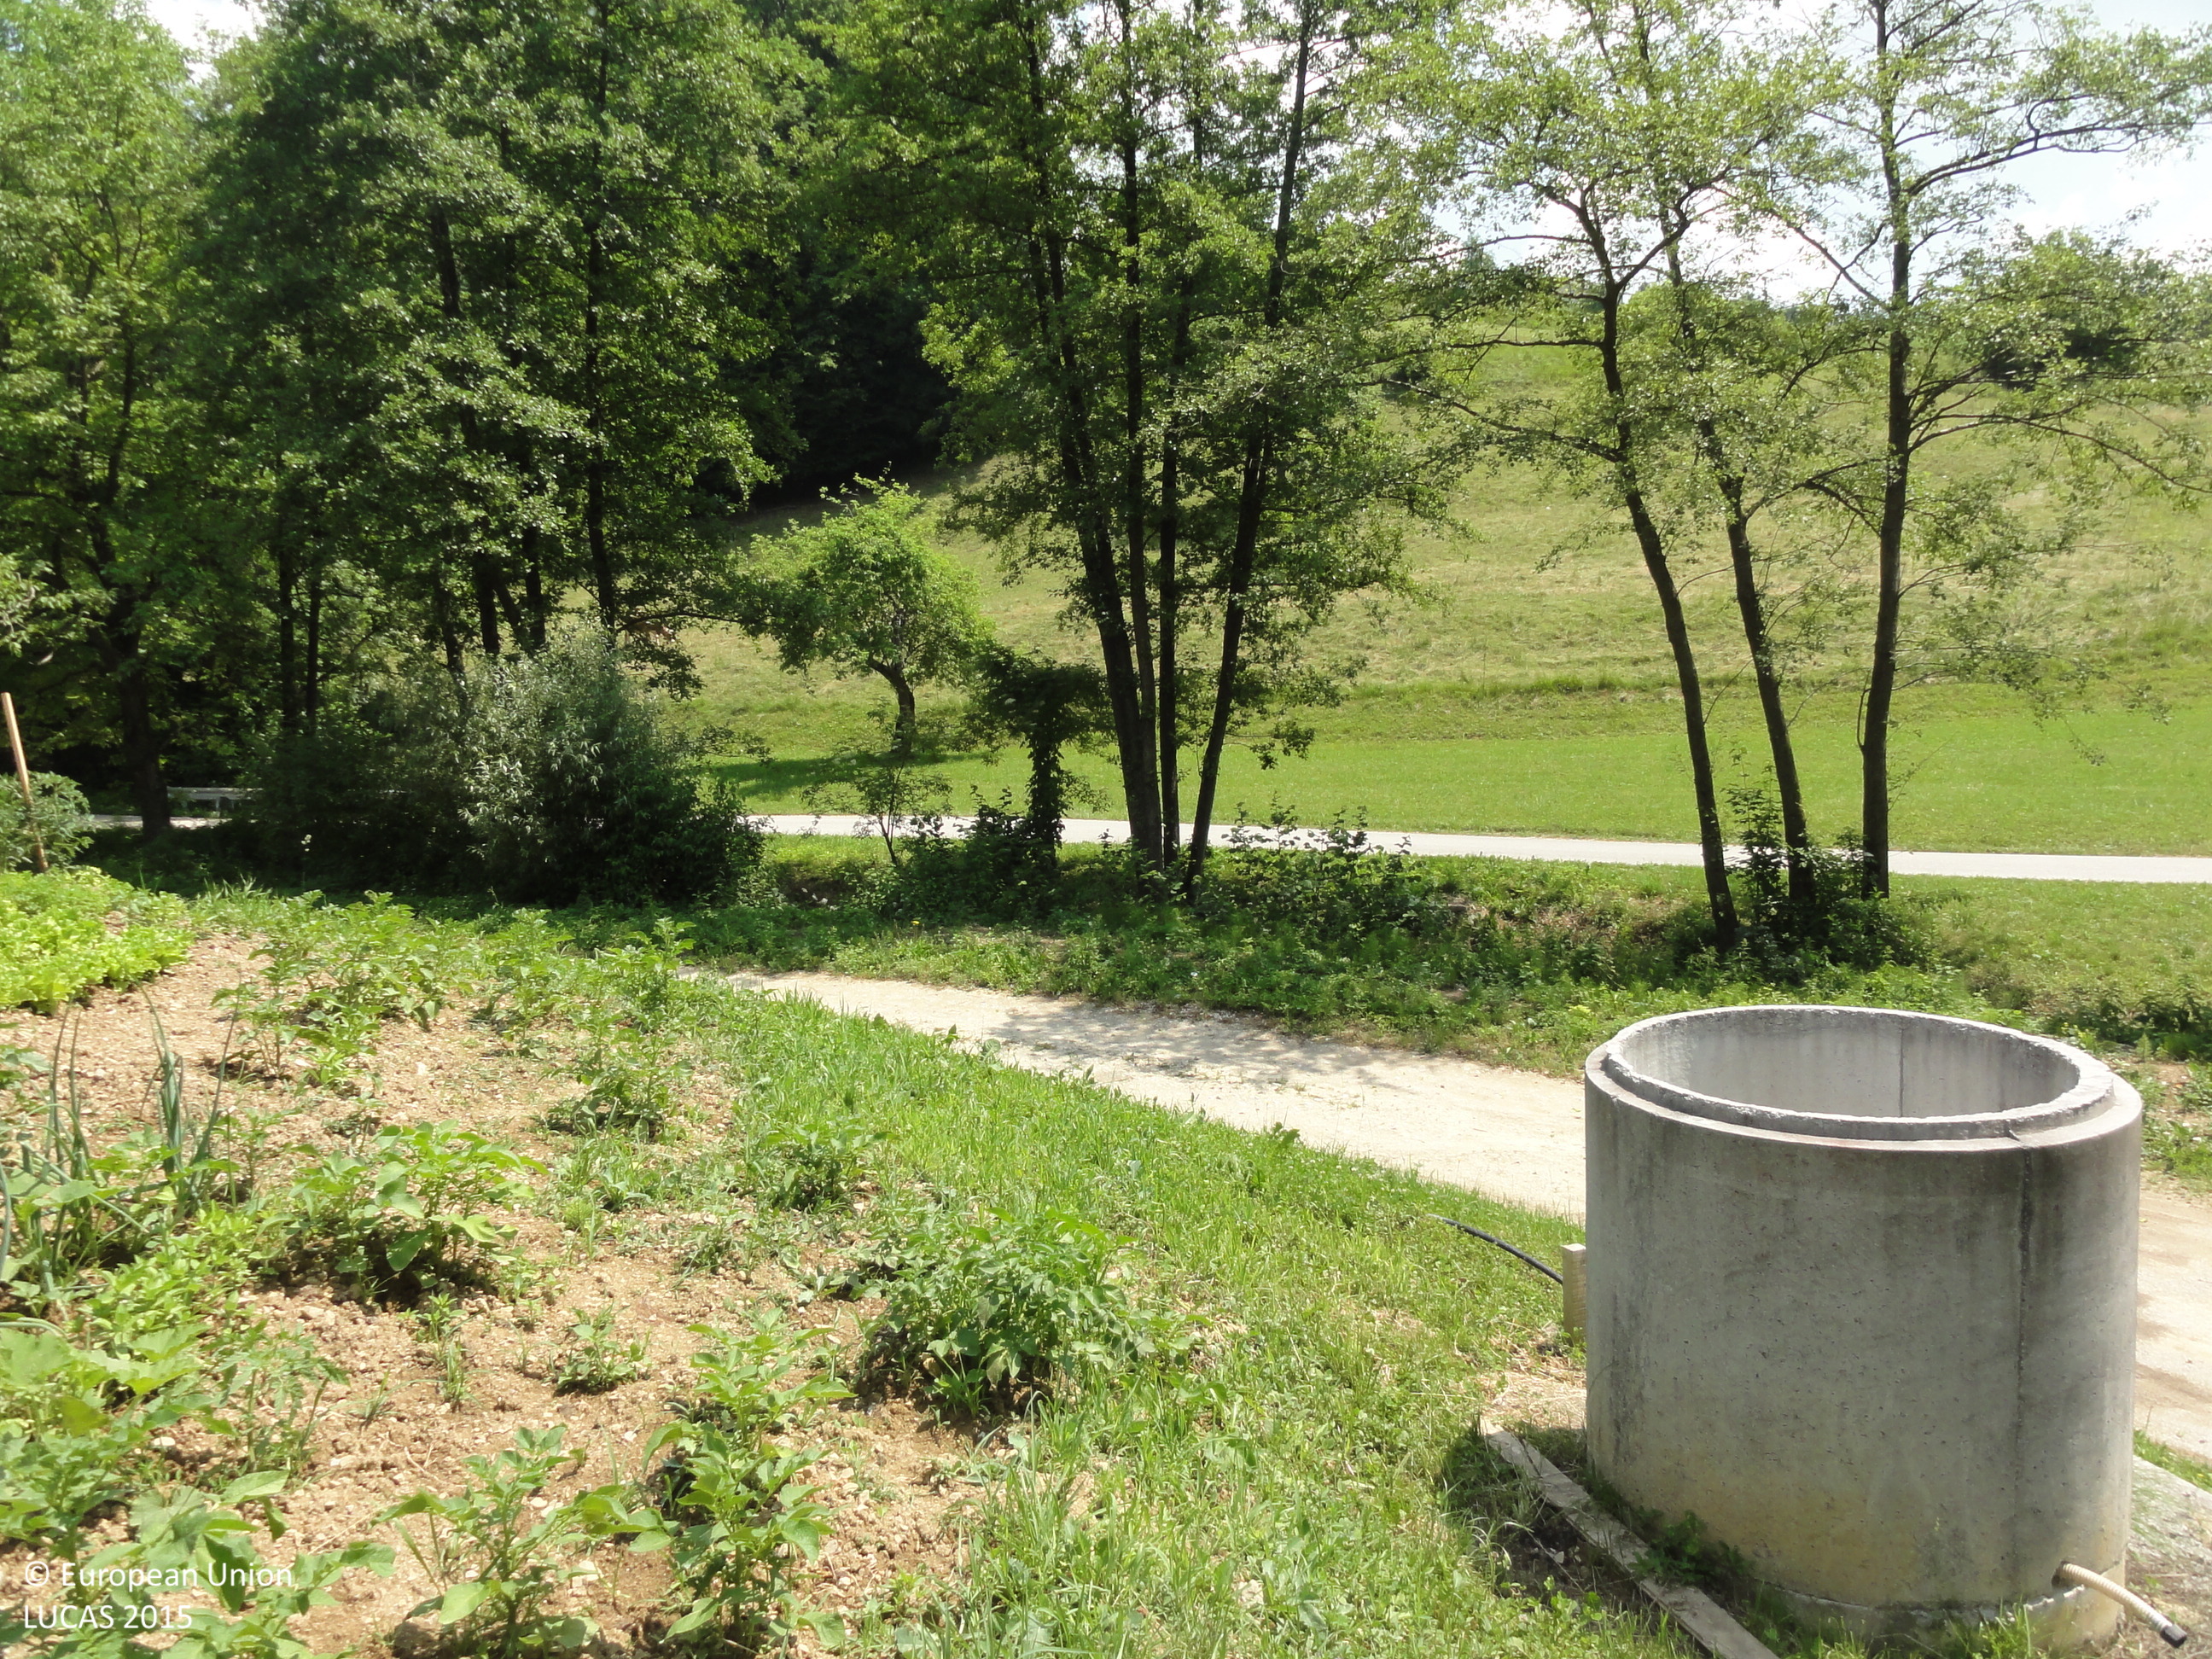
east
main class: Grassland
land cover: Grassland without tree/shrub cover
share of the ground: > 75 %
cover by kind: herbaceous plants 100 %
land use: Residential
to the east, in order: Grassland without tree/shrub cover; Tracks; Abandoned hedges; Rivers and streams; Abandoned hedges; Grass margins; Paved roads, cycling and walking lanes; Grassland with sparse tree/shrub cover; Fences; Grassland without tree/shrub cover; Apple fruit; Grassland with sparse tree/shrub cover; Fences; Grassland with sparse tree/shrub cover; Apple fruit; Grassland without tree/shrub cover; Tracks; Broadleaved woodland; Grassland without tree/shrub cover; Apple fruit
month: June
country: SI
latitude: 46.3302
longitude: 15.2588
